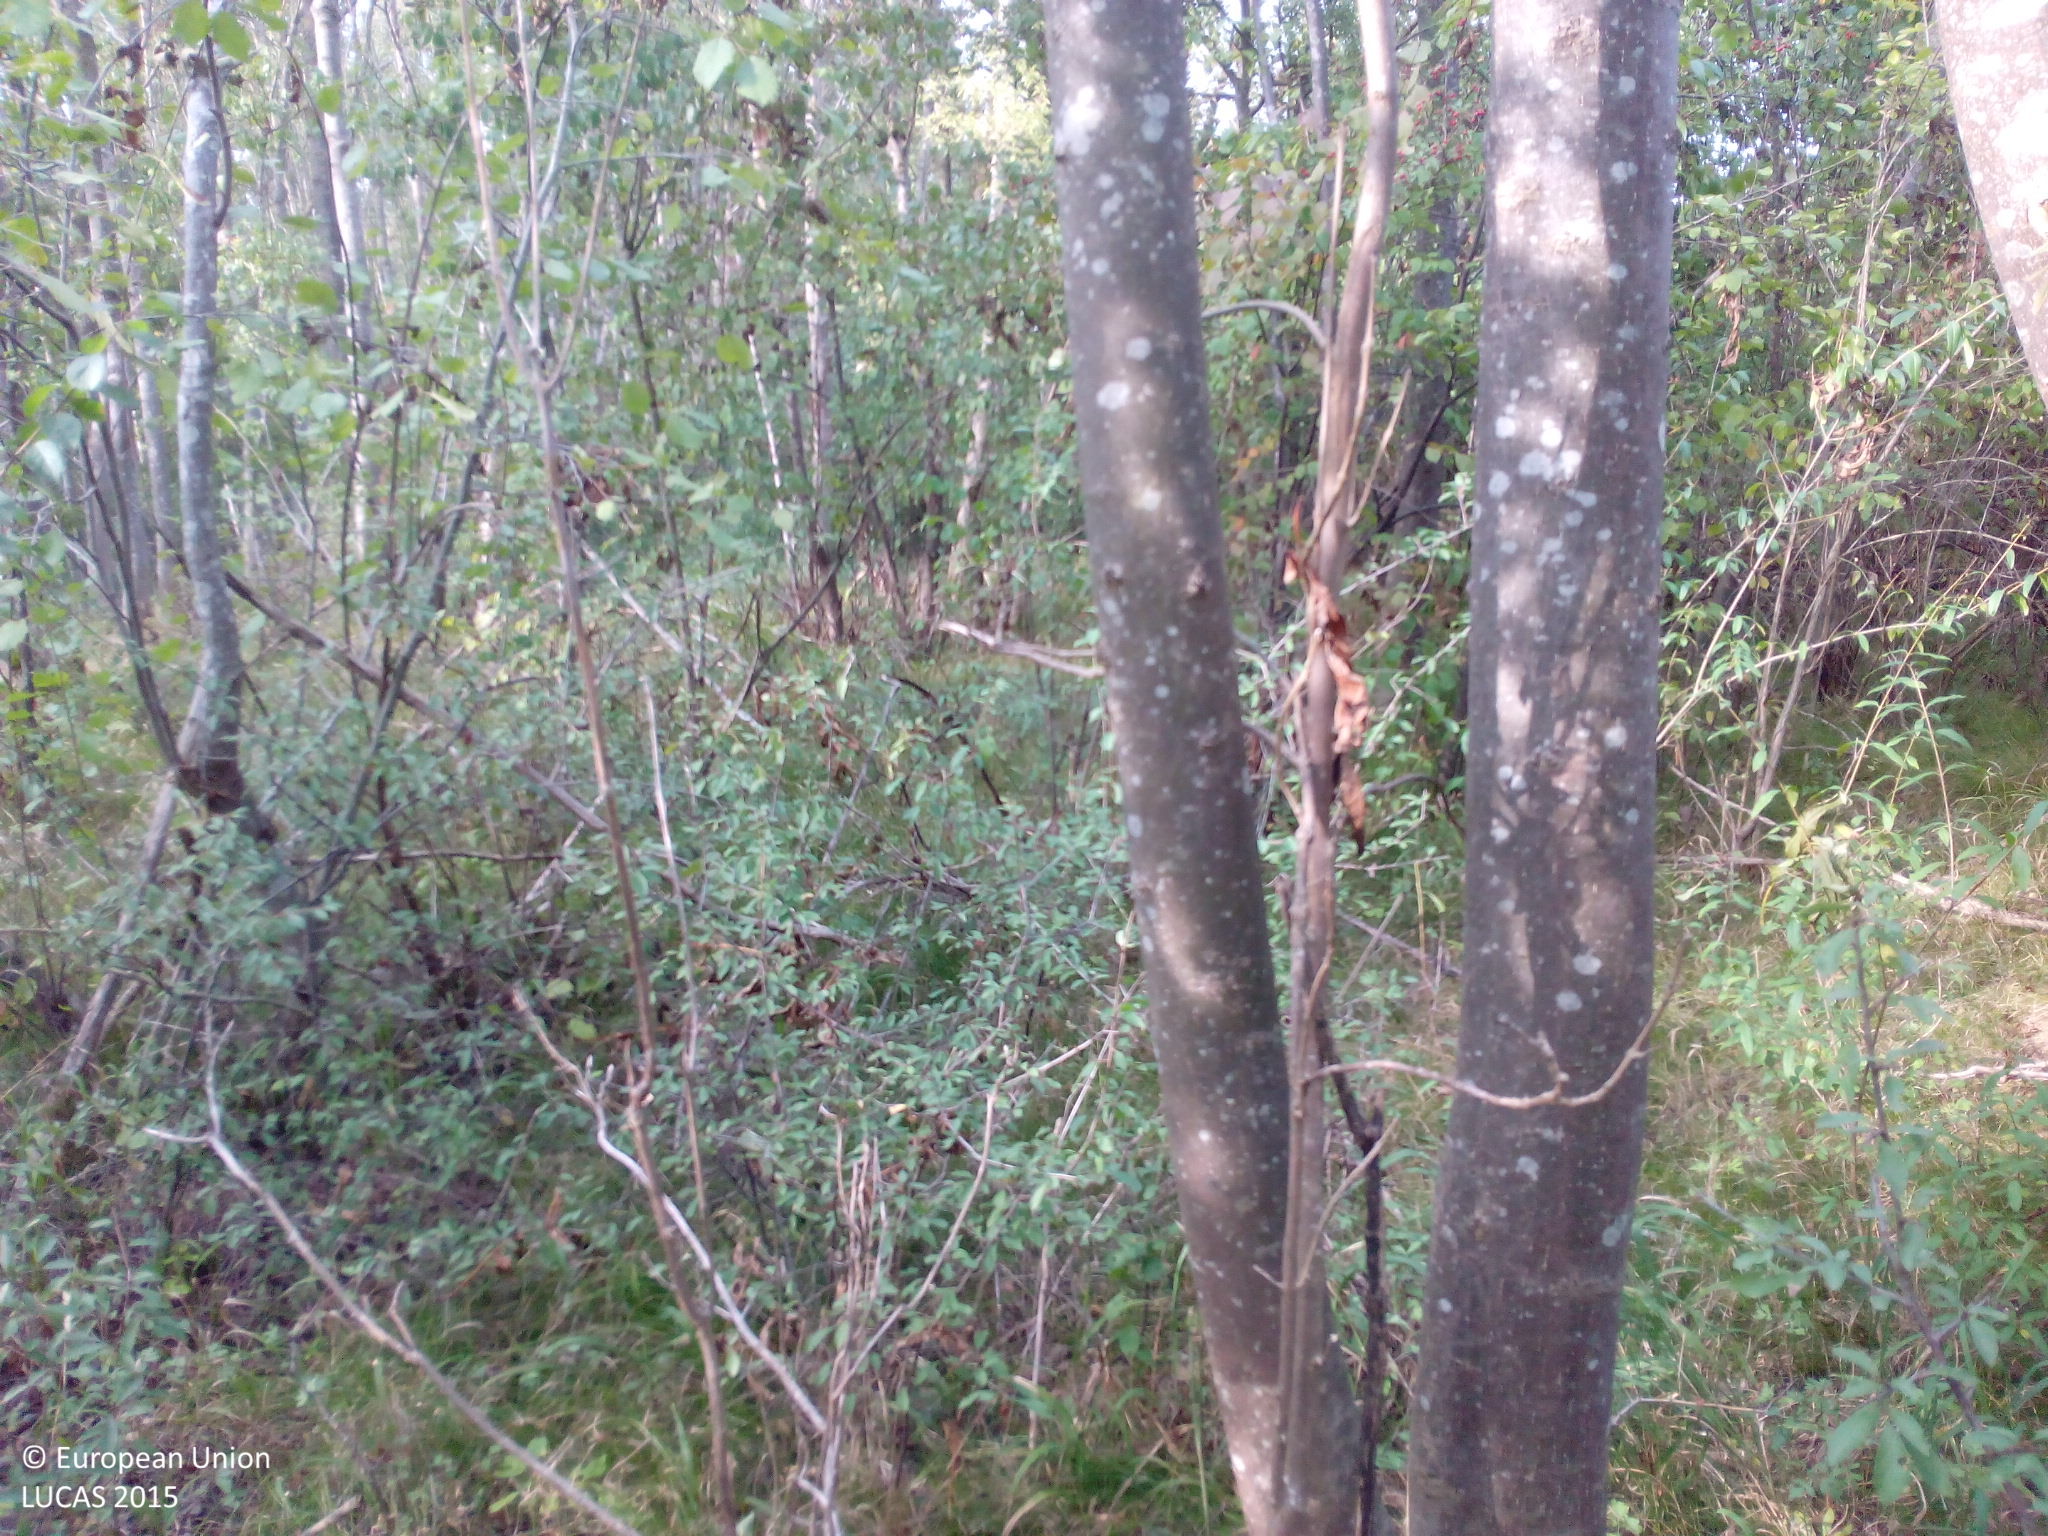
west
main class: Woodland
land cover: Broadleaved woodland
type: mesophytic deciduous forest
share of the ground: > 75 %
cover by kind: broadleaved forest trees 80 %, shrubs 10 %, herbaceous plants 10 %
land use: Protection infrastructures
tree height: > 5 m
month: September
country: DE
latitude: 48.4720
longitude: 10.8787
